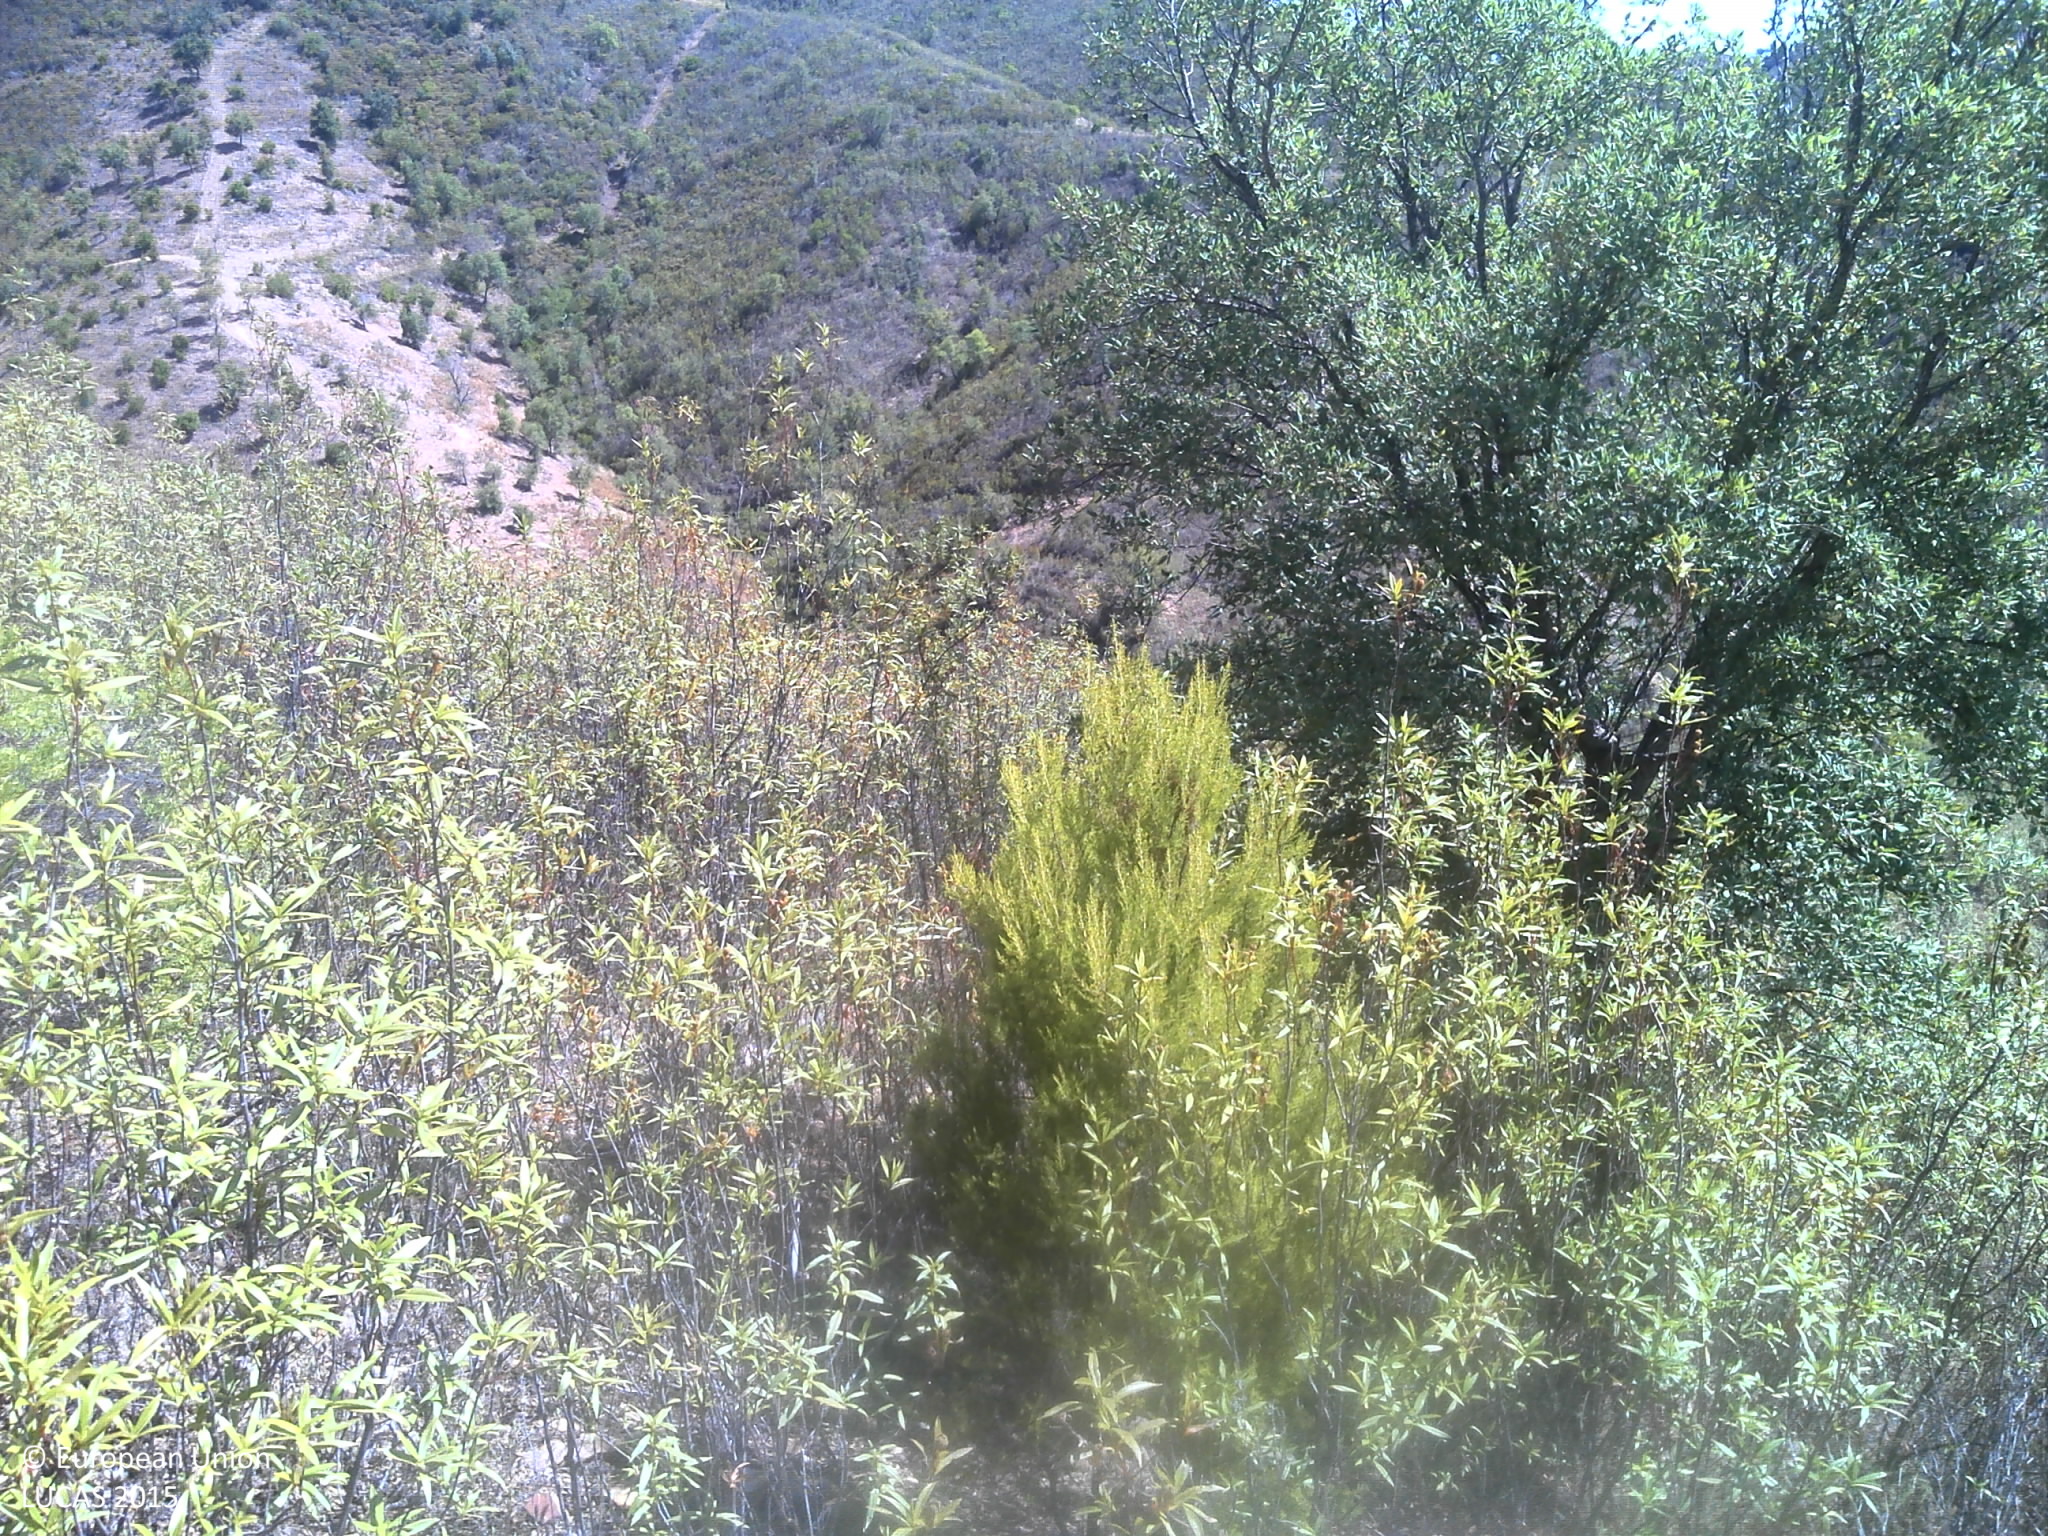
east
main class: Shrubland
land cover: Shrubland with sparse tree cover
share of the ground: 25 - 50 %
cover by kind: shrubs 50 %, unconsolidated bare surface 35 %, herbaceous plants 10 %, broadleaved forest trees 5 %
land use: Semi-natural and natural areas not in use
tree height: < 5 m
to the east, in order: Shrubland with sparse tree cover; Rivers and streams; Shrubland with sparse tree cover; Shrubland without tree cover
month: September
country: PT
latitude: 37.3269
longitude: -8.2025
